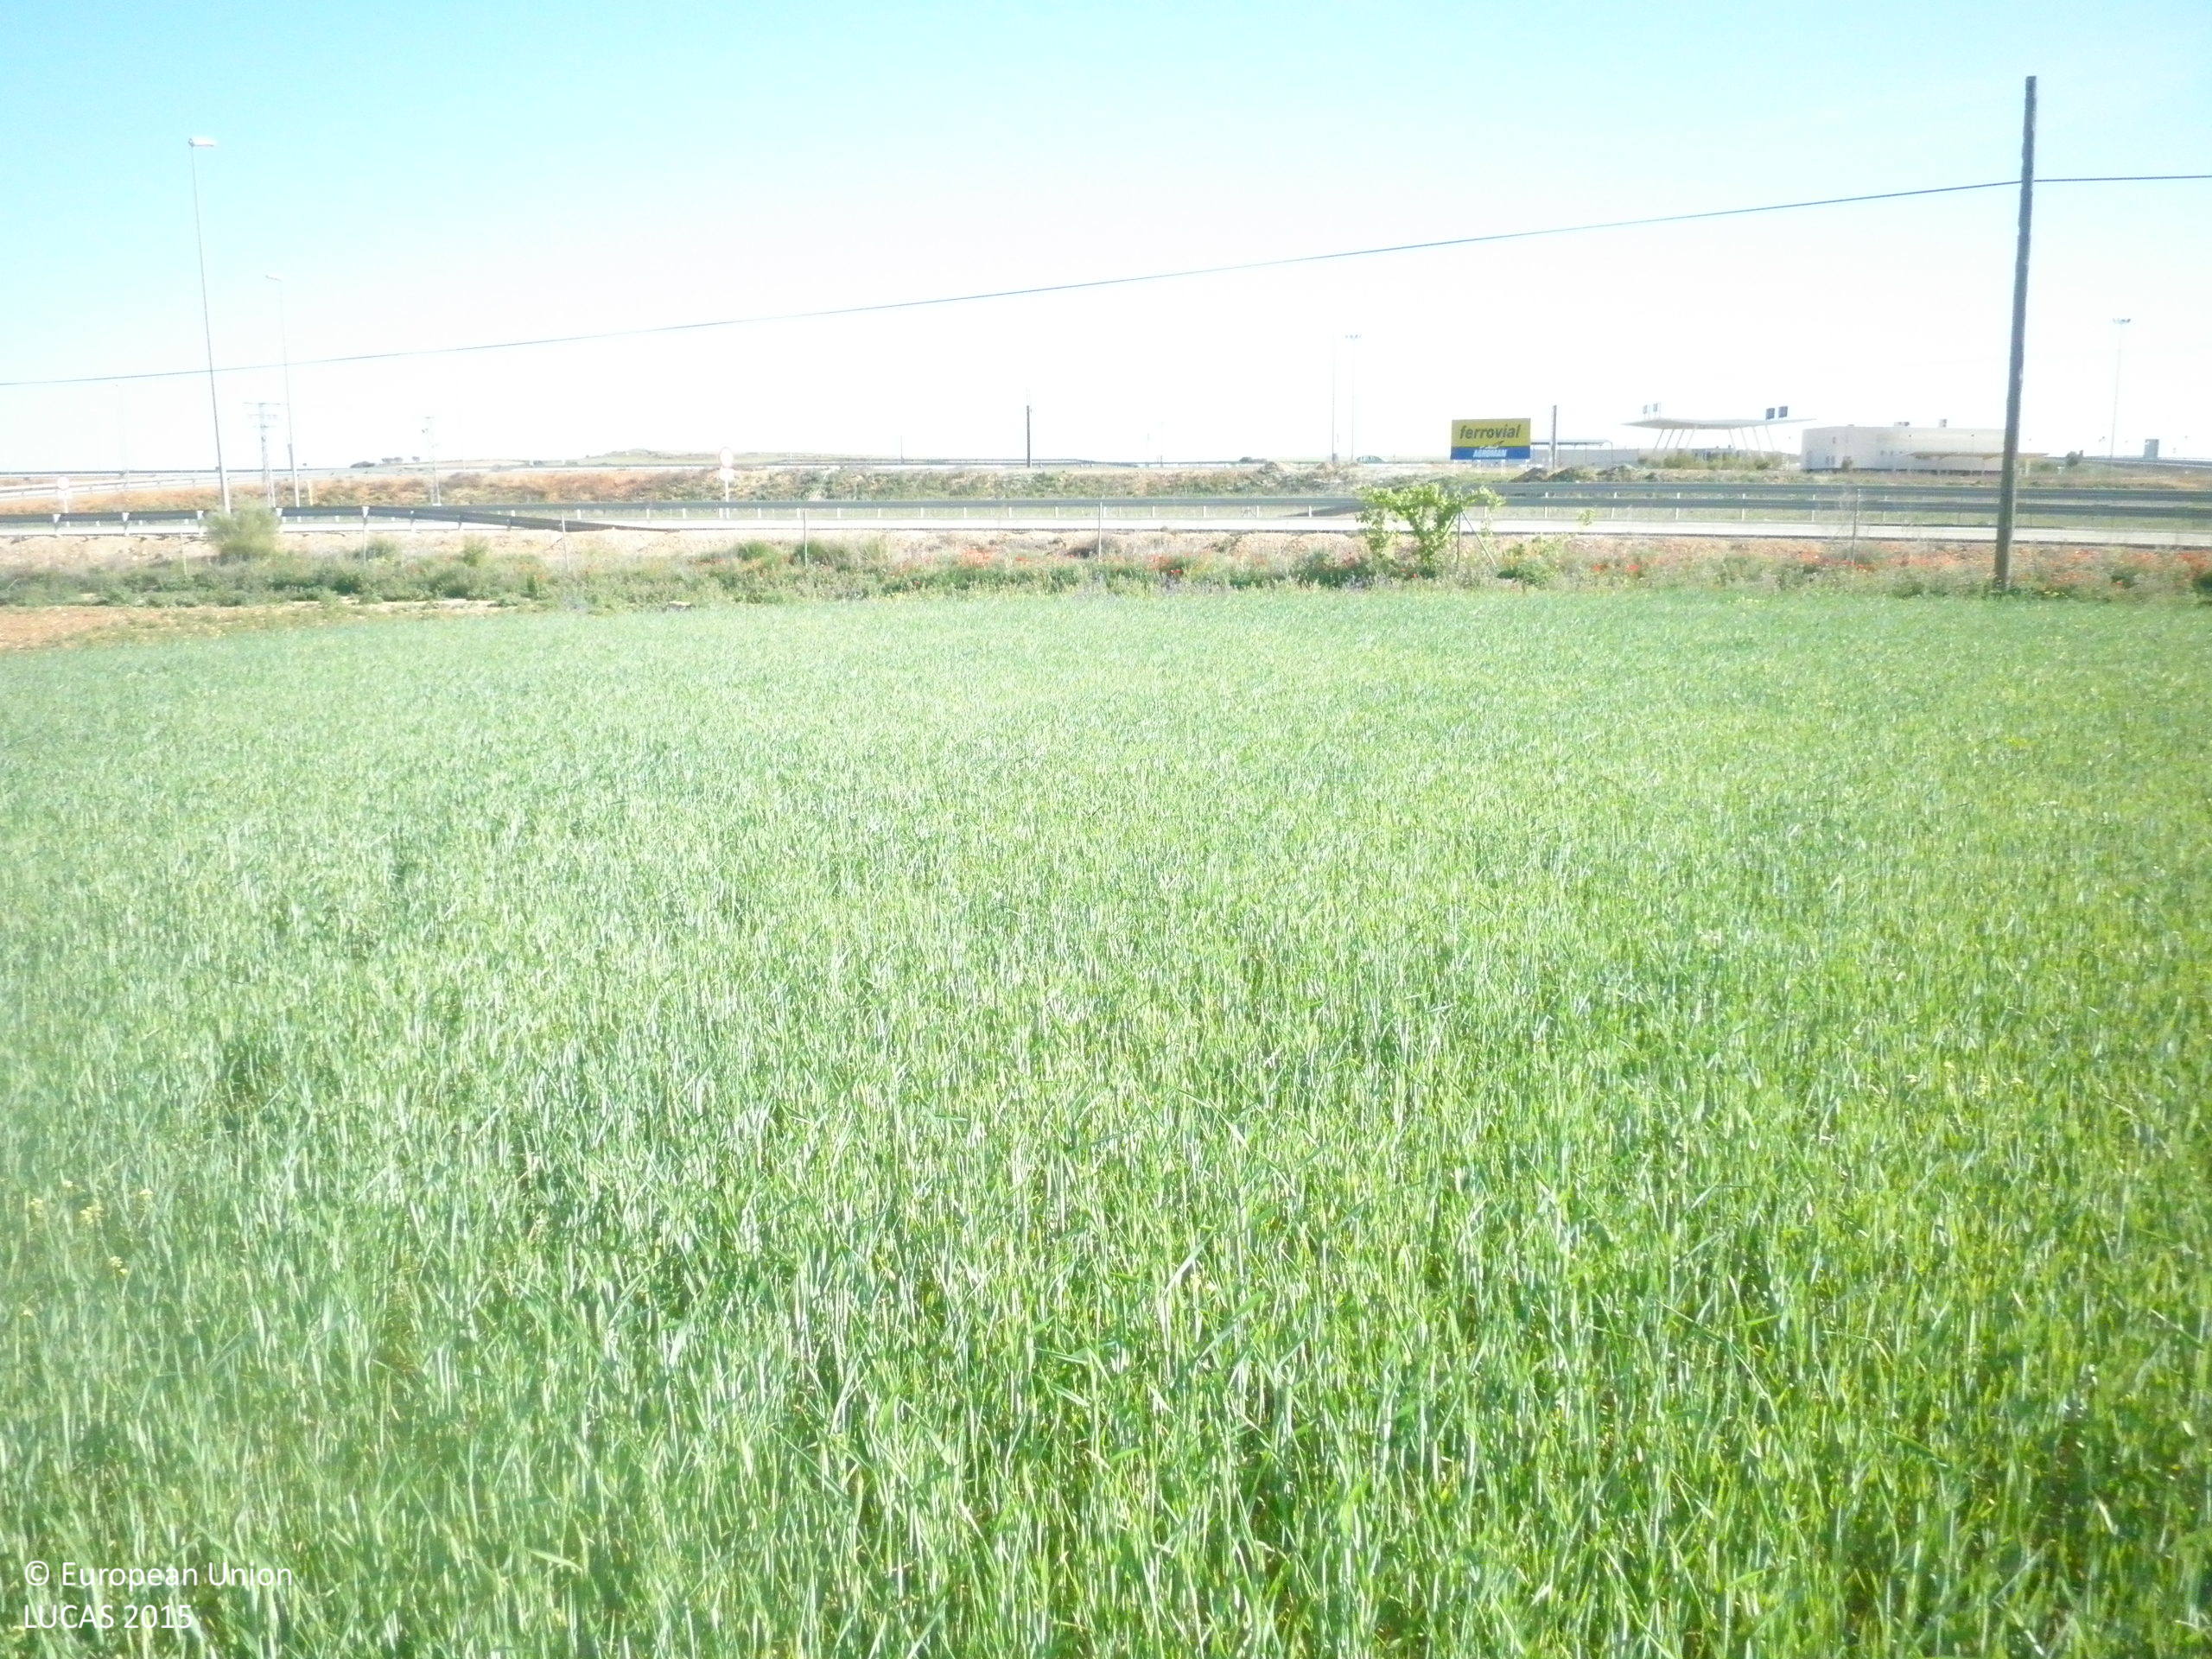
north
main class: Cropland
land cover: Durum wheat
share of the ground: > 75 %
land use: Agriculture (excluding fallow land and kitchen gardens)
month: May
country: ES
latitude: 39.4724
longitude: -2.7193
